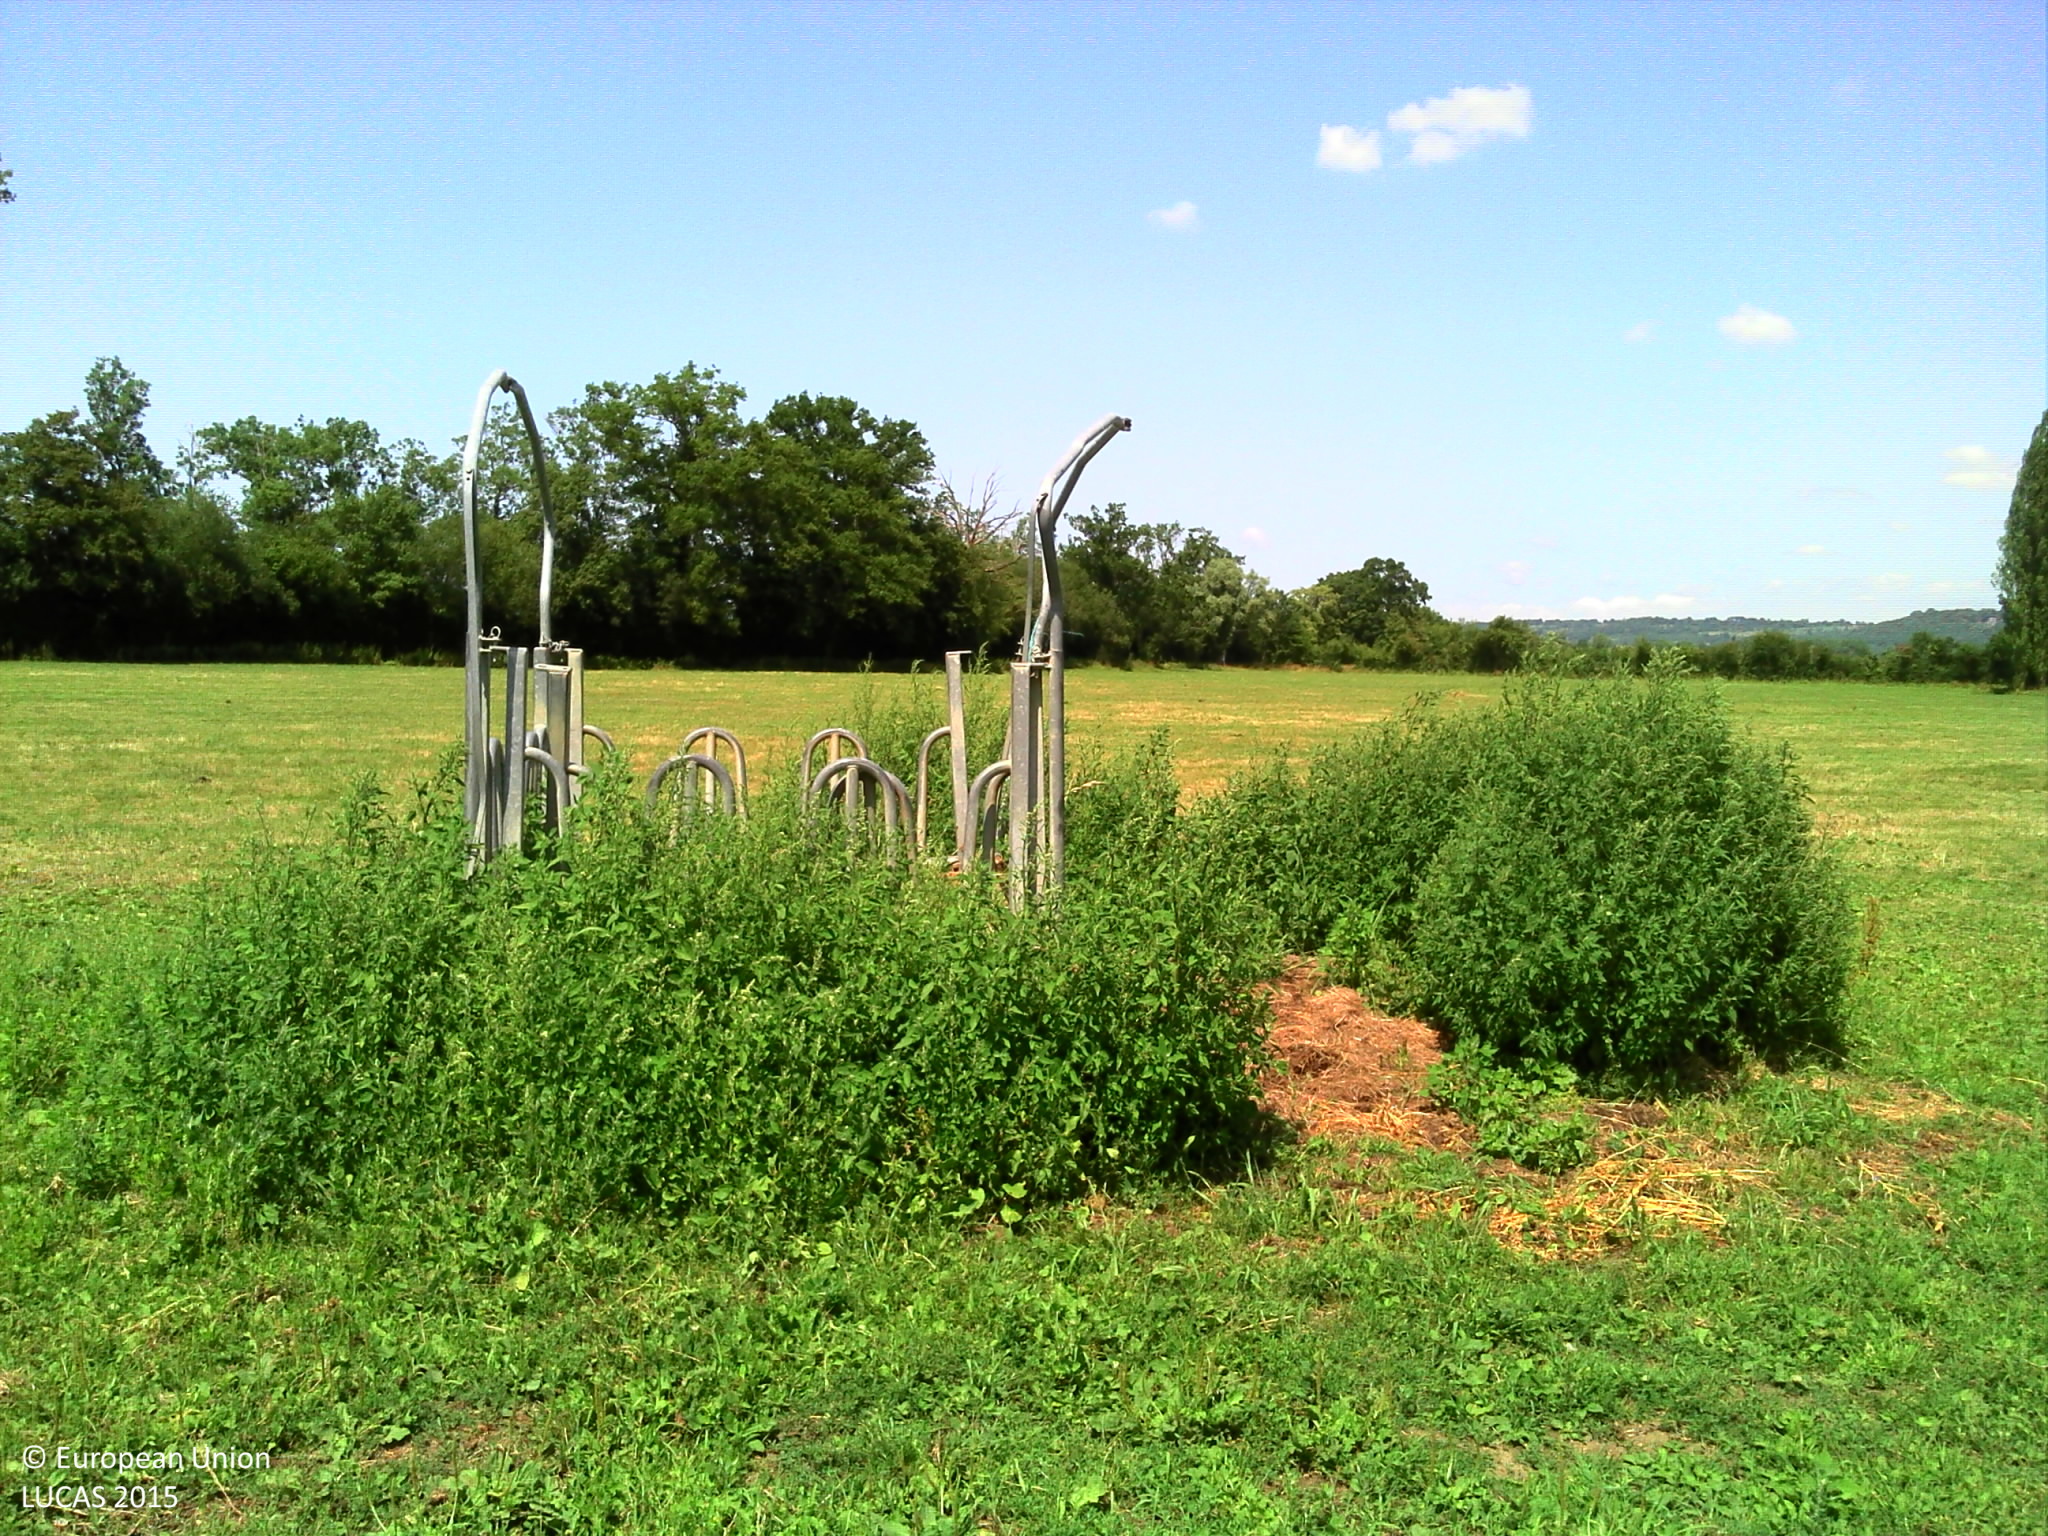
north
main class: Grassland
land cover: Grassland without tree/shrub cover
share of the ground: > 75 %
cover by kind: herbaceous plants 100 %
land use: Agriculture (excluding fallow land and kitchen gardens)
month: July
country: FR
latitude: 49.0898
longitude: -0.0136
